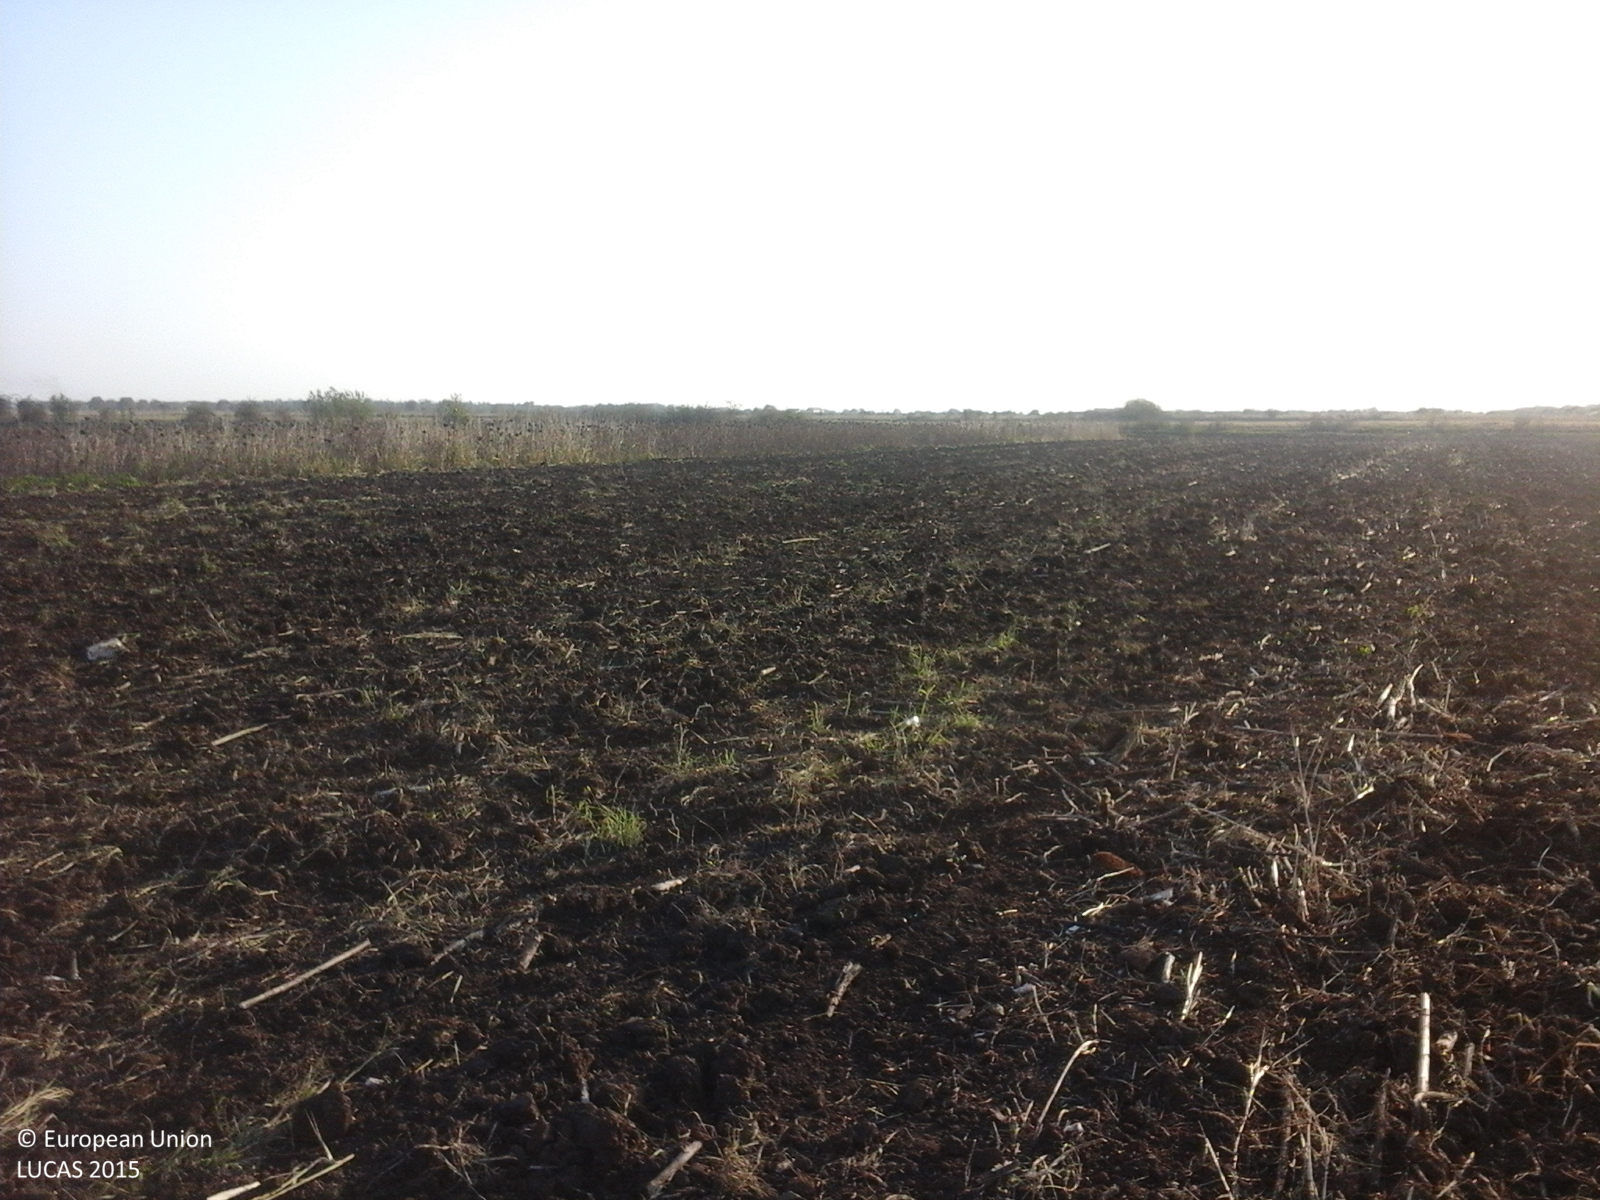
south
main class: Cropland
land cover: Sunflower
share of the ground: < 10 %
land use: Agriculture (excluding fallow land and kitchen gardens)
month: October
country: RO
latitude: 45.1574
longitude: 26.9120
